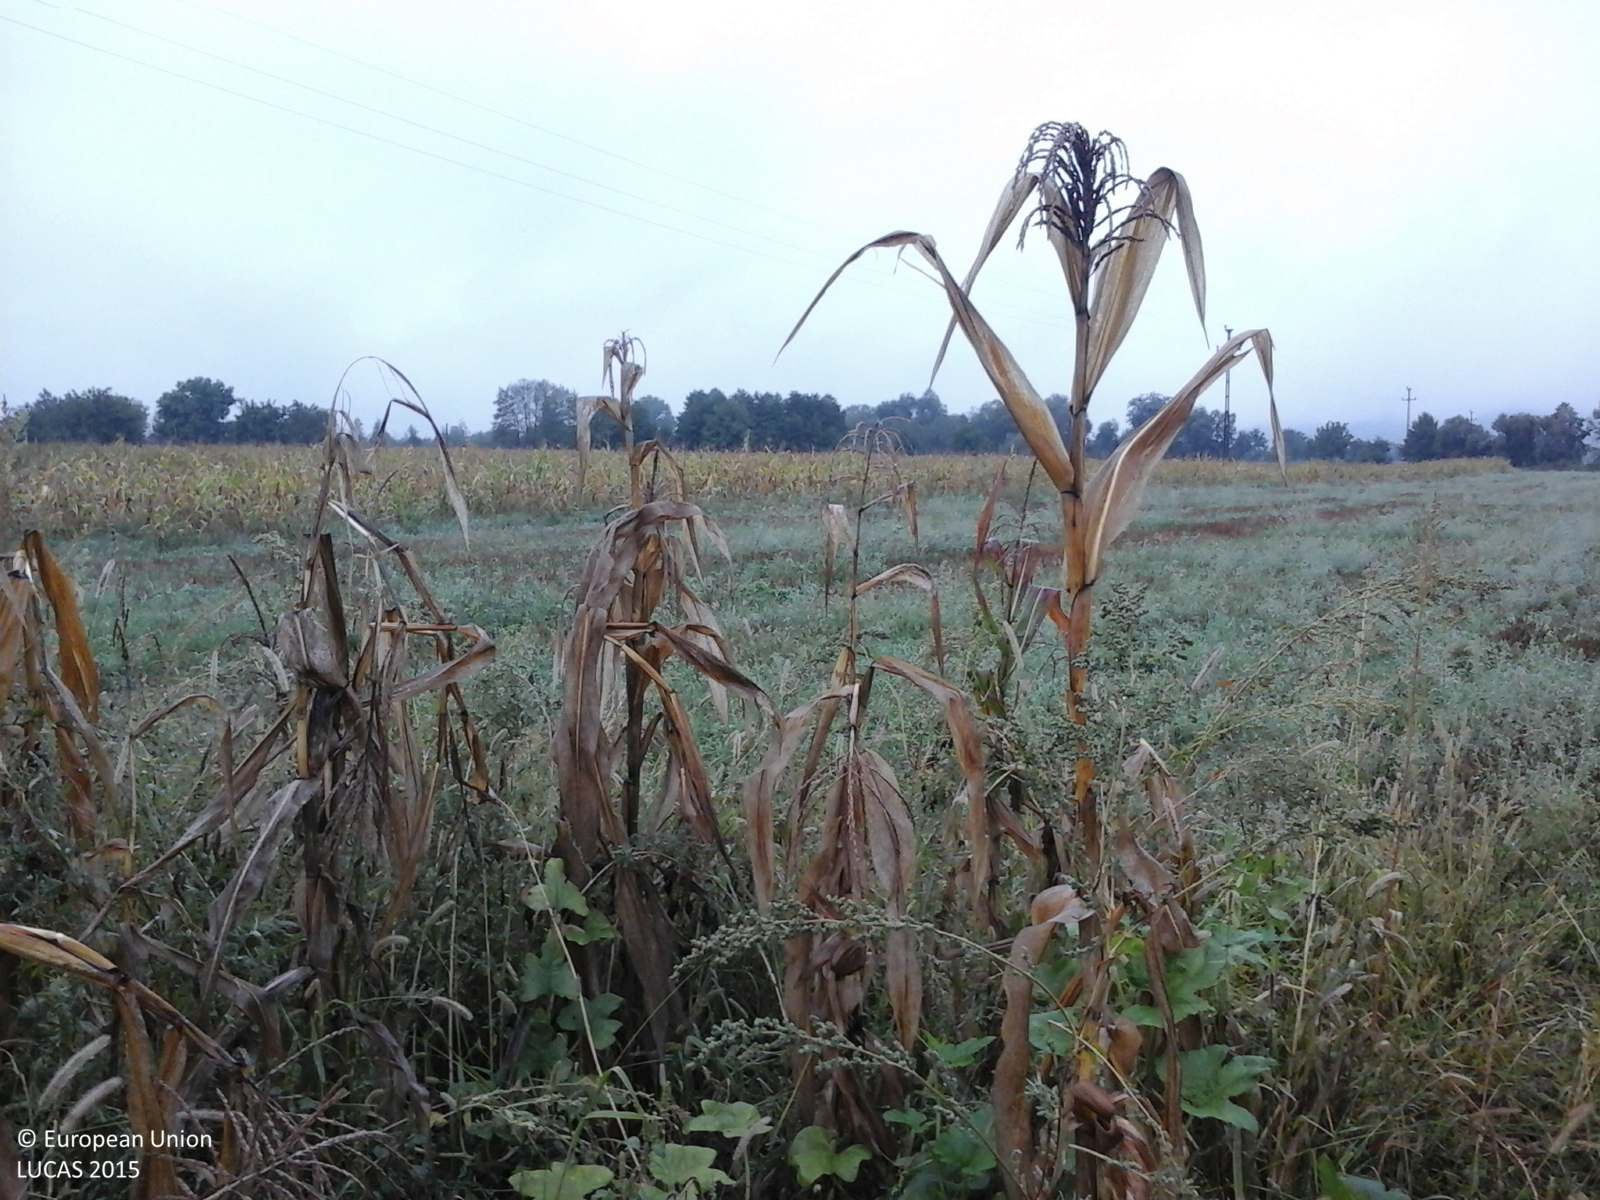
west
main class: Cropland
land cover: Maize
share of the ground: > 75 %
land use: Agriculture (excluding fallow land and kitchen gardens)
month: September
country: RO
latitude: 47.0364
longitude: 22.4906
